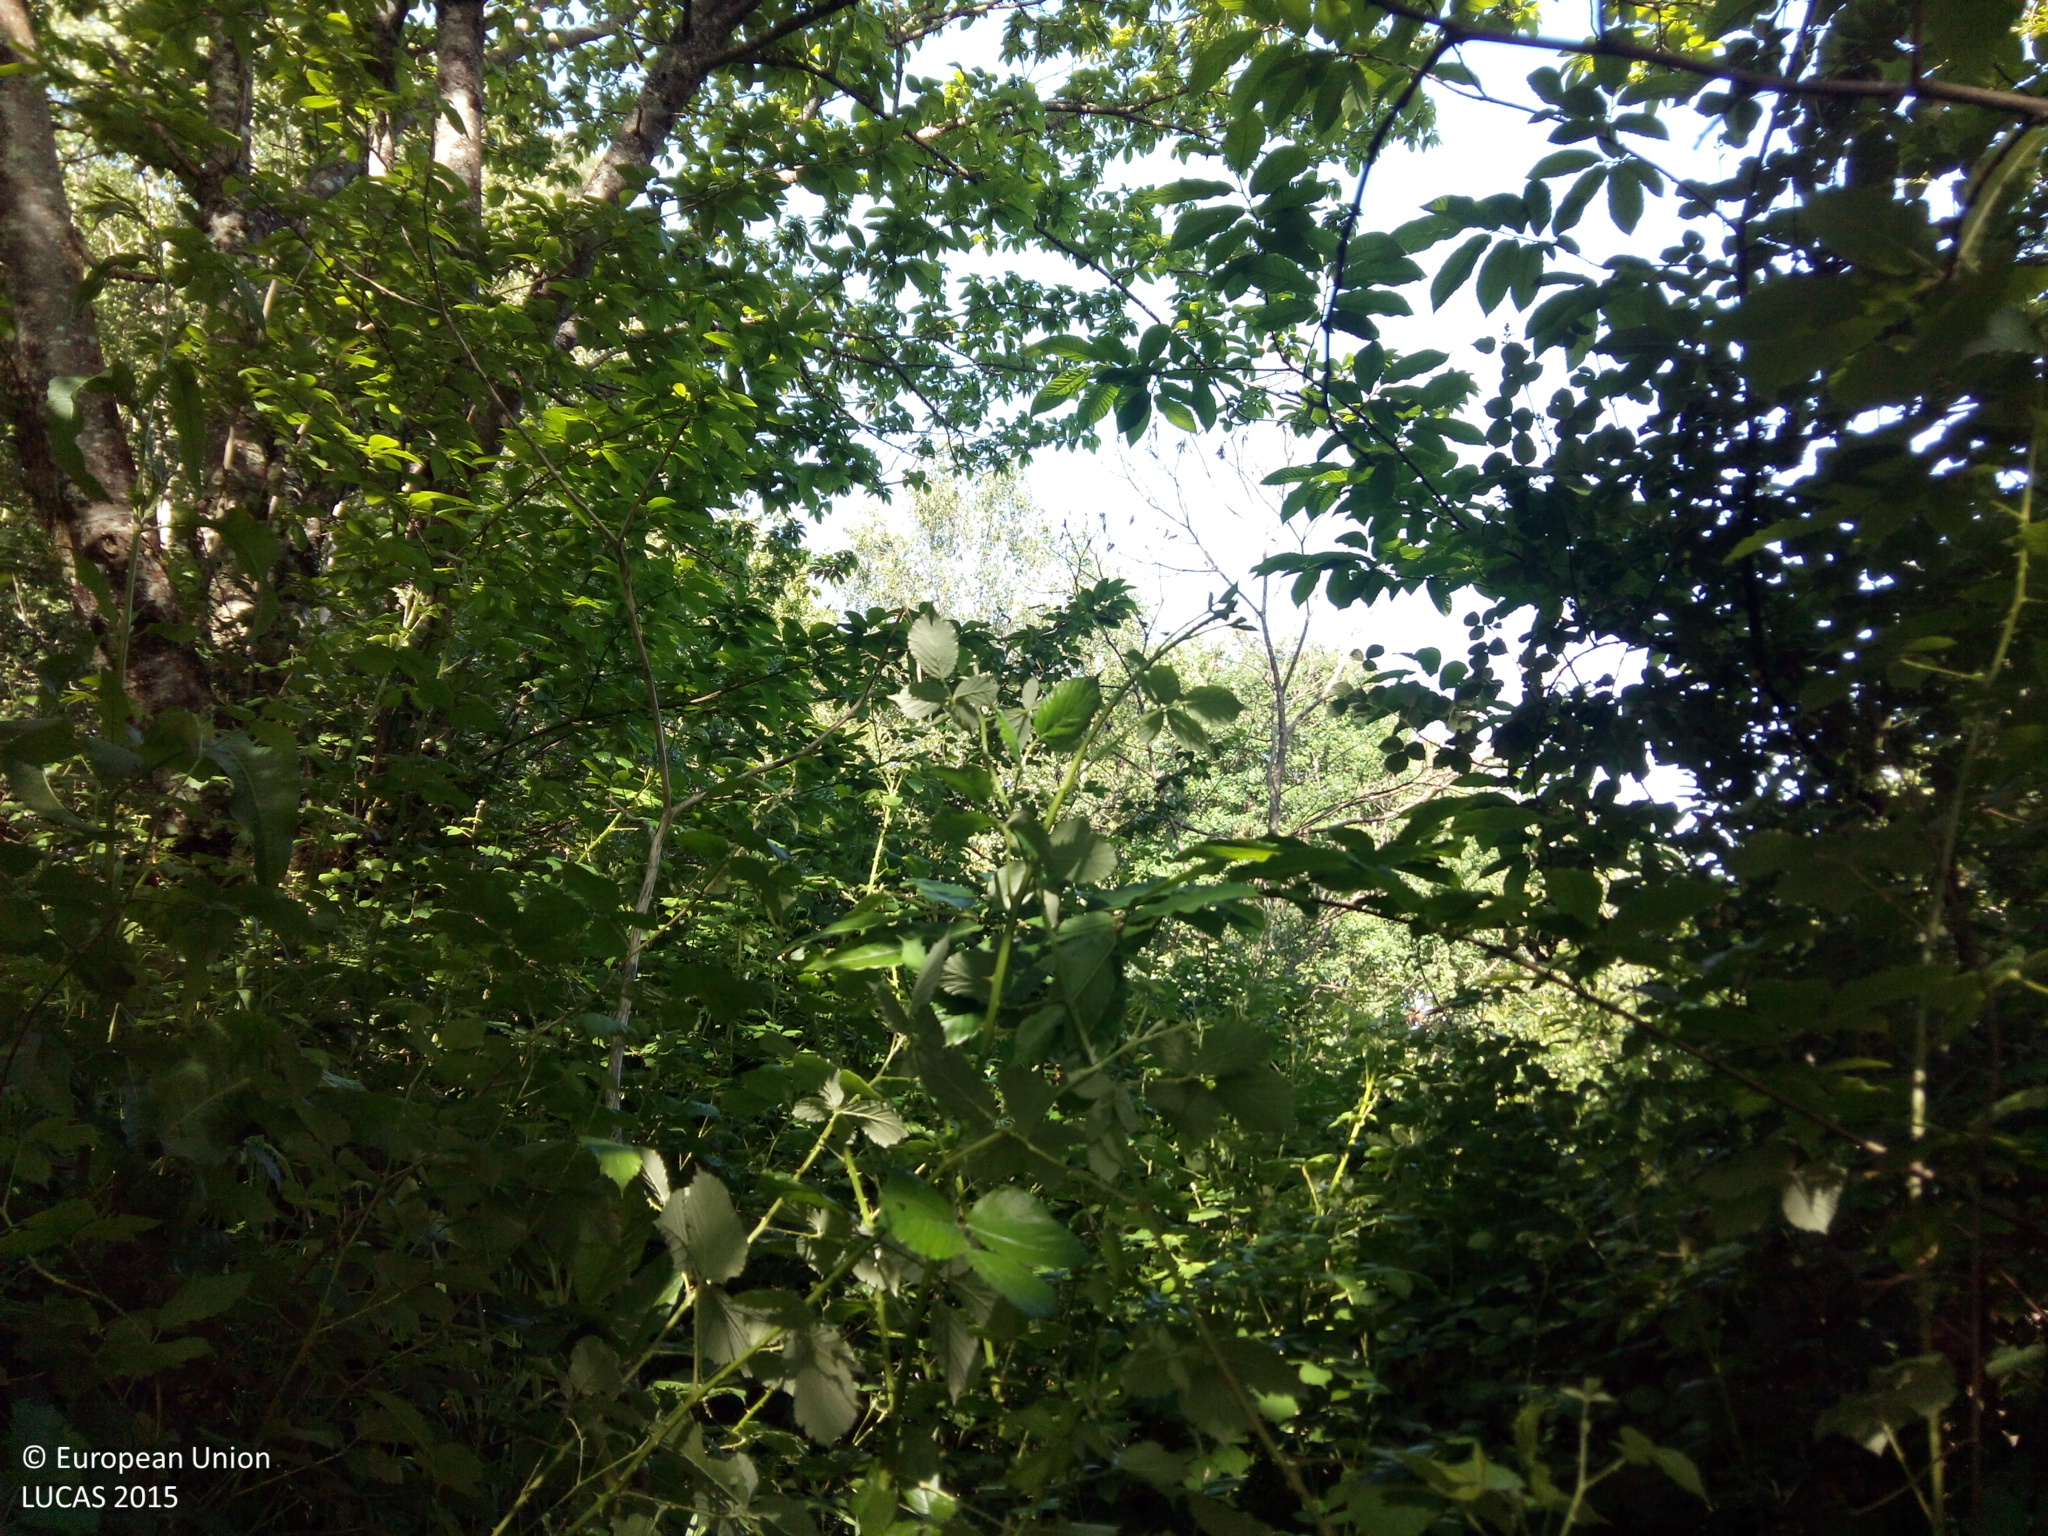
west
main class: Woodland
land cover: Broadleaved woodland
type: acidophilous oak and oak-birch forest
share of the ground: > 75 %
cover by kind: broadleaved forest trees 100 %
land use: Forestry
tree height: > 5 m
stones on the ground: 10 - 25 %
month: May
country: ES
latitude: 42.6800
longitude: -8.4408
